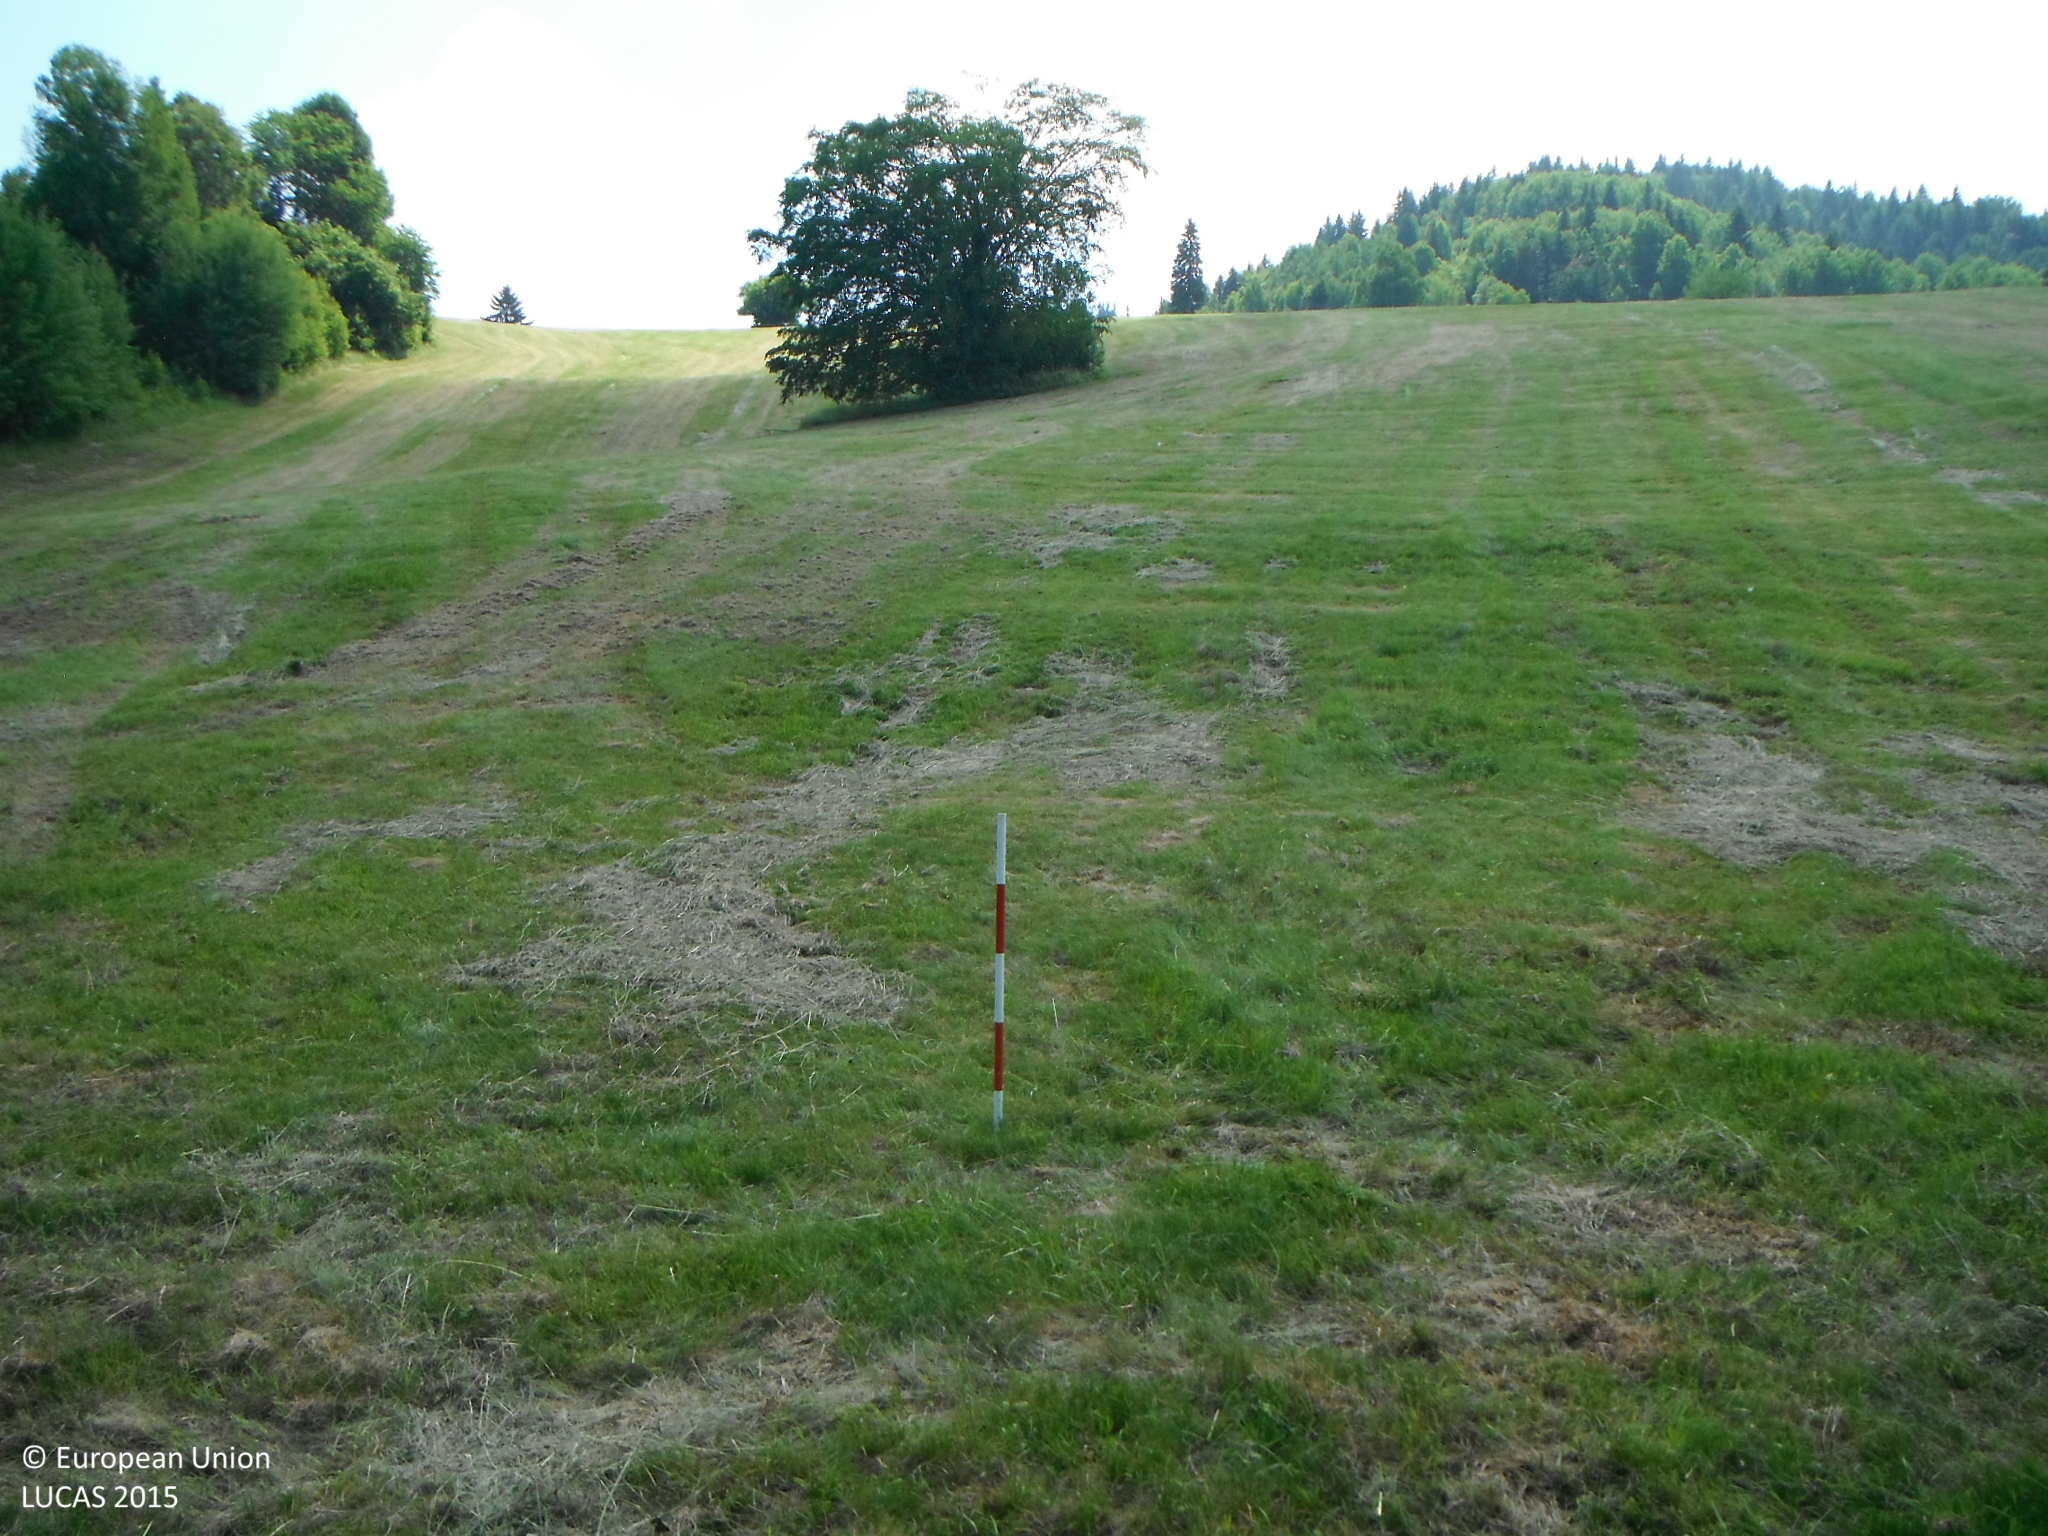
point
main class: Grassland
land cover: Grassland without tree/shrub cover
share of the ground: > 75 %
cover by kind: herbaceous plants 100 %
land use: Agriculture (excluding fallow land and kitchen gardens)
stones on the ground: < 10 %
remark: Harvested field
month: June
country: SK
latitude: 48.7097
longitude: 19.3878
